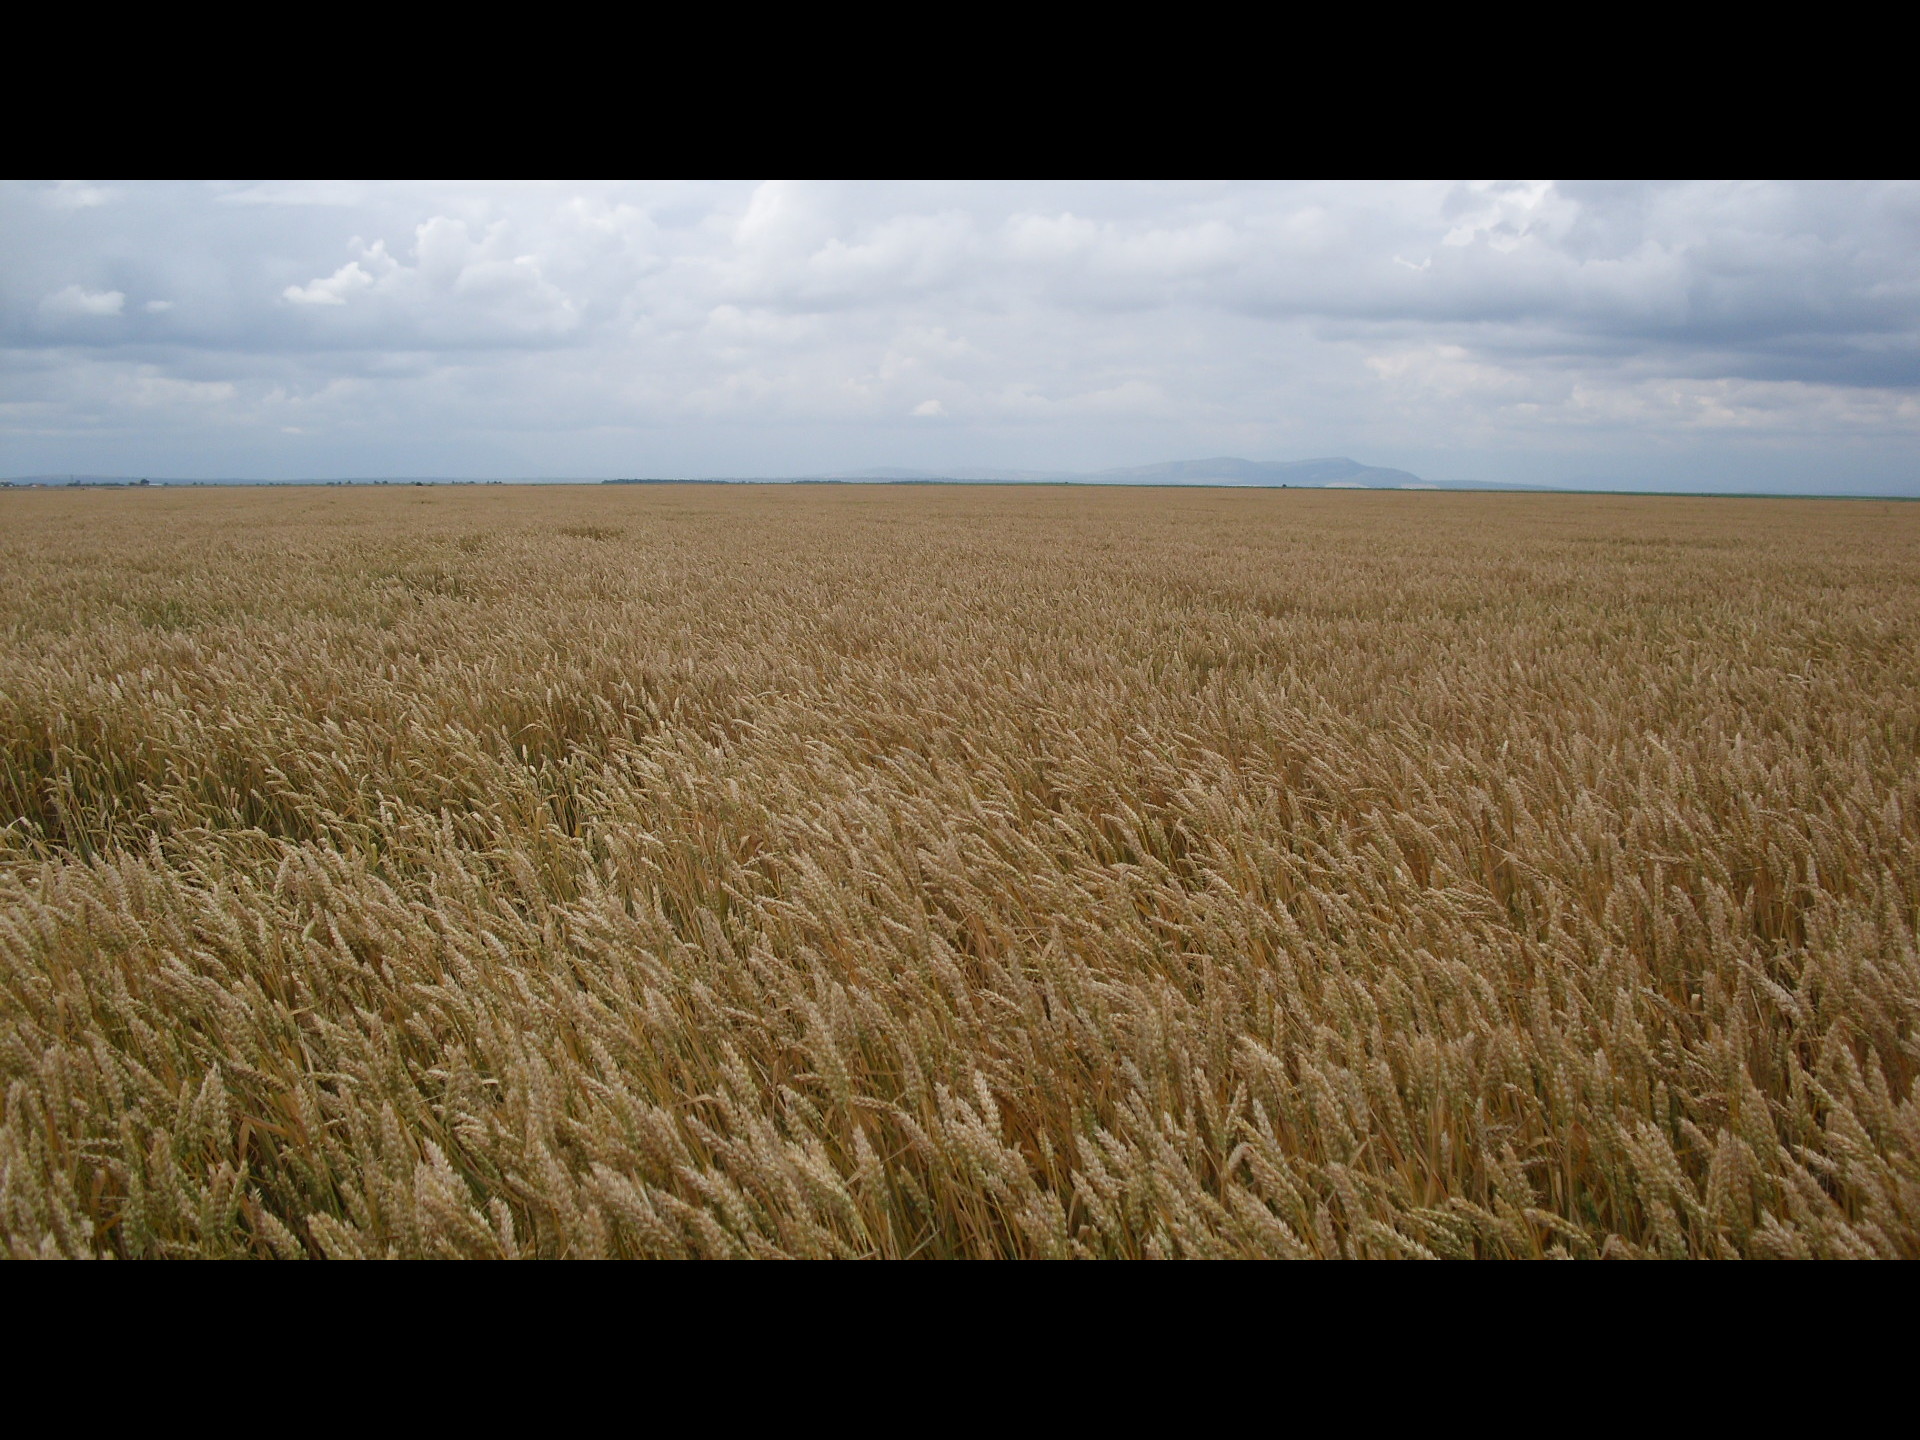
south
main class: Cropland
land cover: Common wheat
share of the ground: > 75 %
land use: Agriculture (excluding fallow land and kitchen gardens)
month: June
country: BG
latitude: 43.6178
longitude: 23.4401
